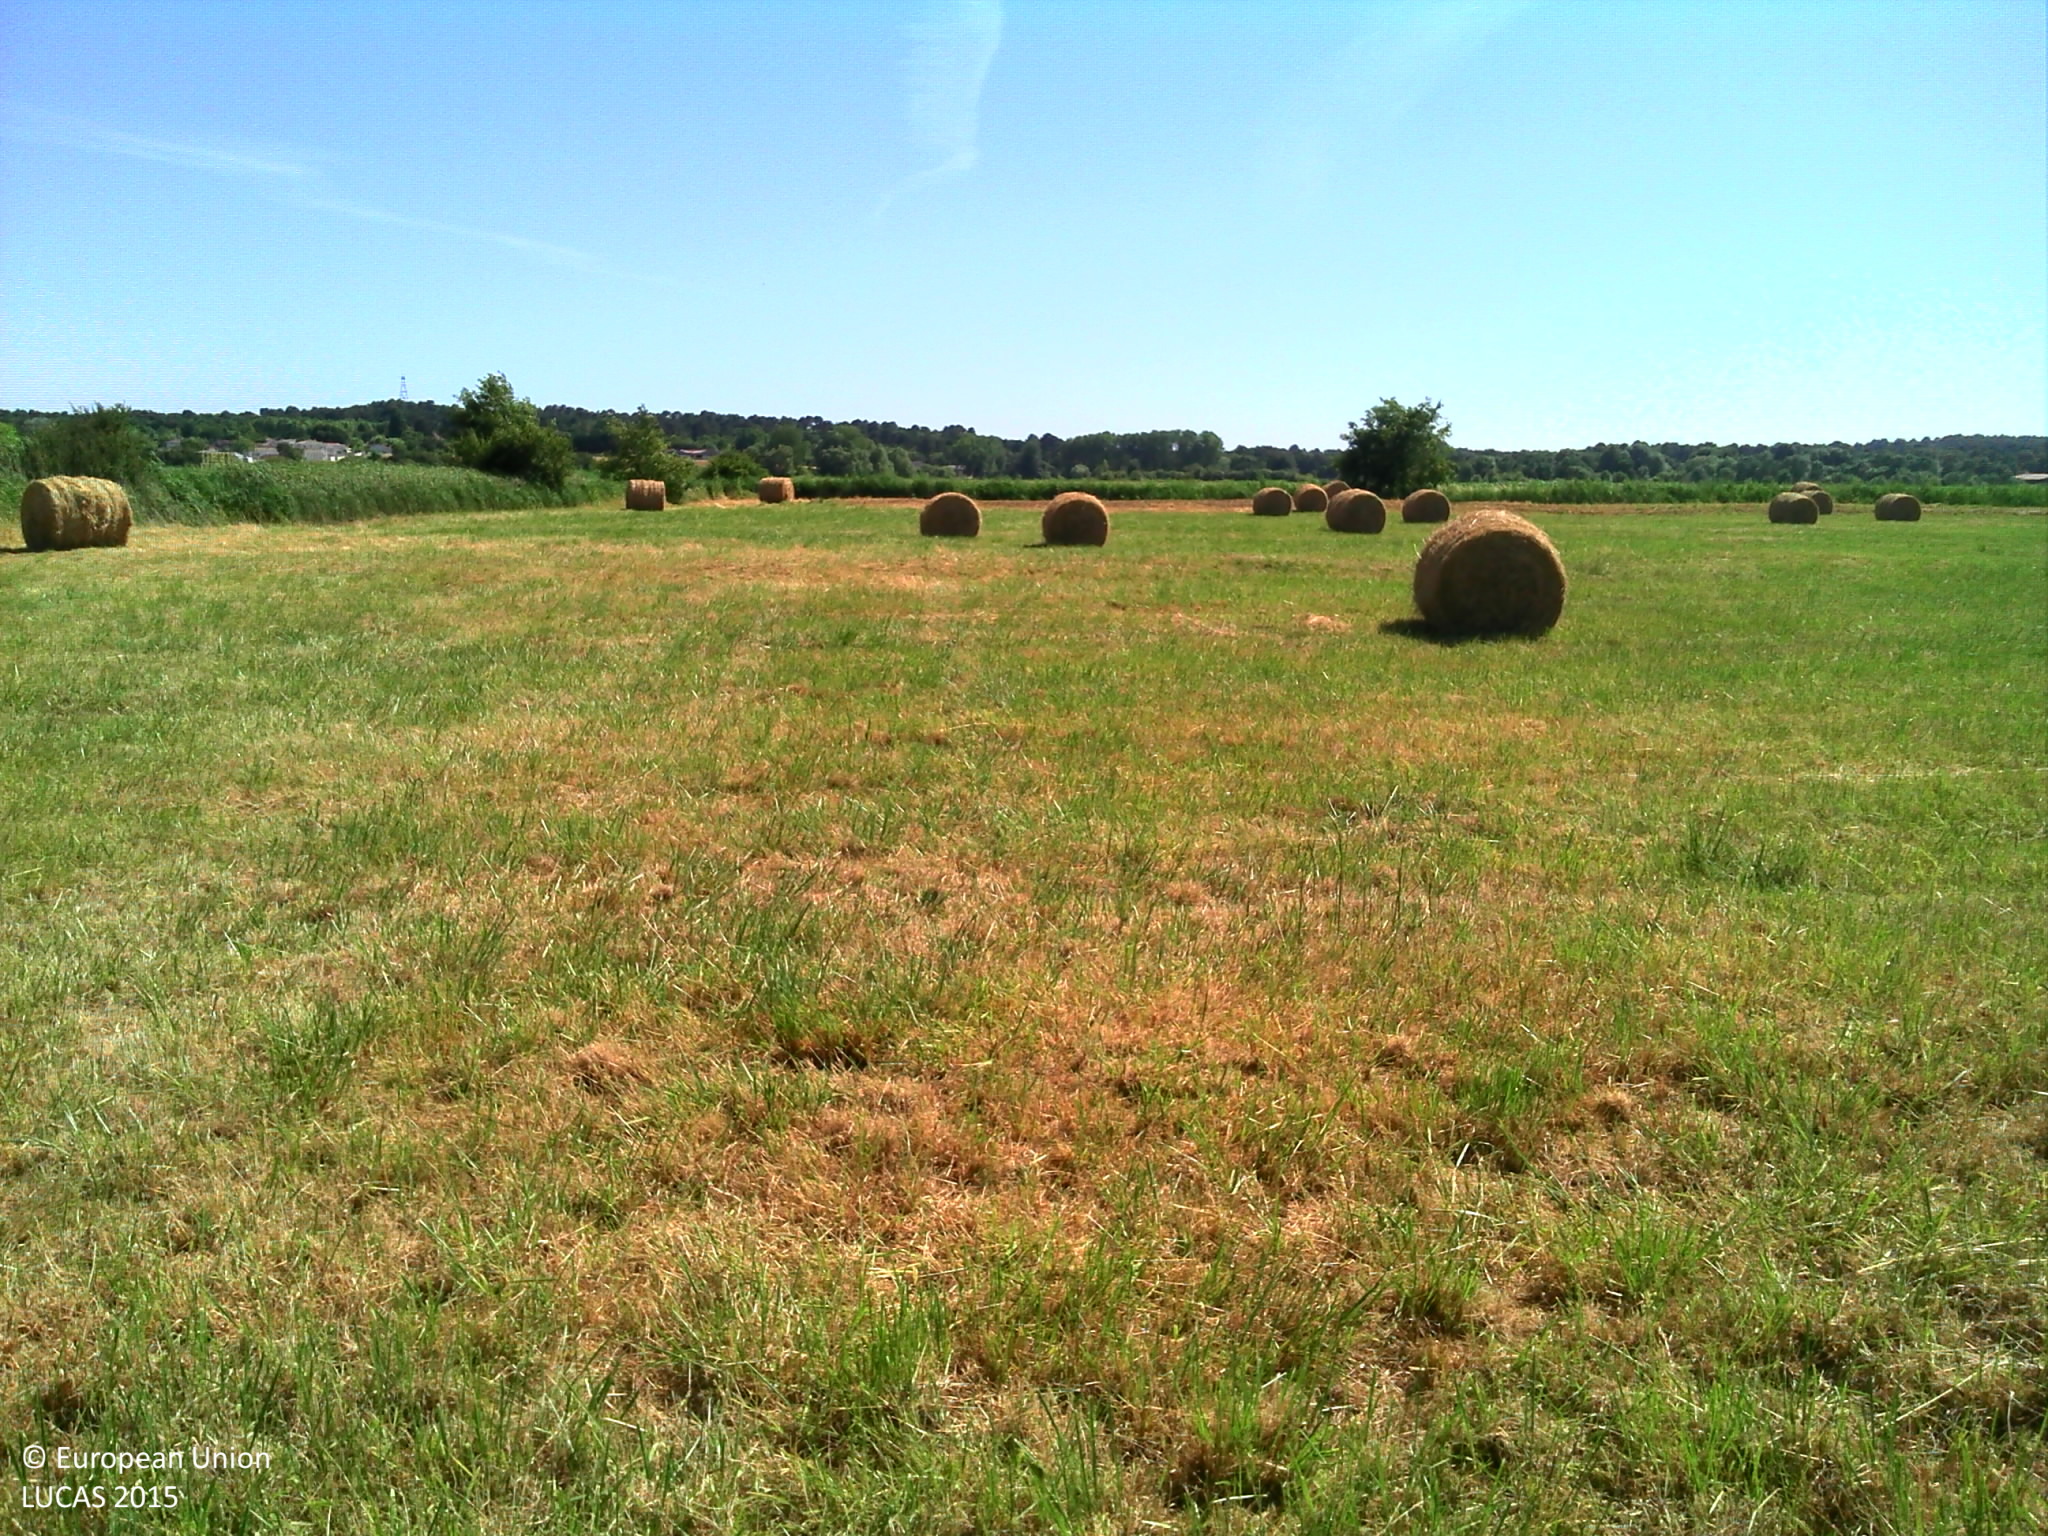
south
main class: Grassland
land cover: Grassland without tree/shrub cover
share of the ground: > 75 %
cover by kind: herbaceous plants 100 %
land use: Agriculture (excluding fallow land and kitchen gardens)
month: June
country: FR
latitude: 45.6976
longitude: -1.1122
